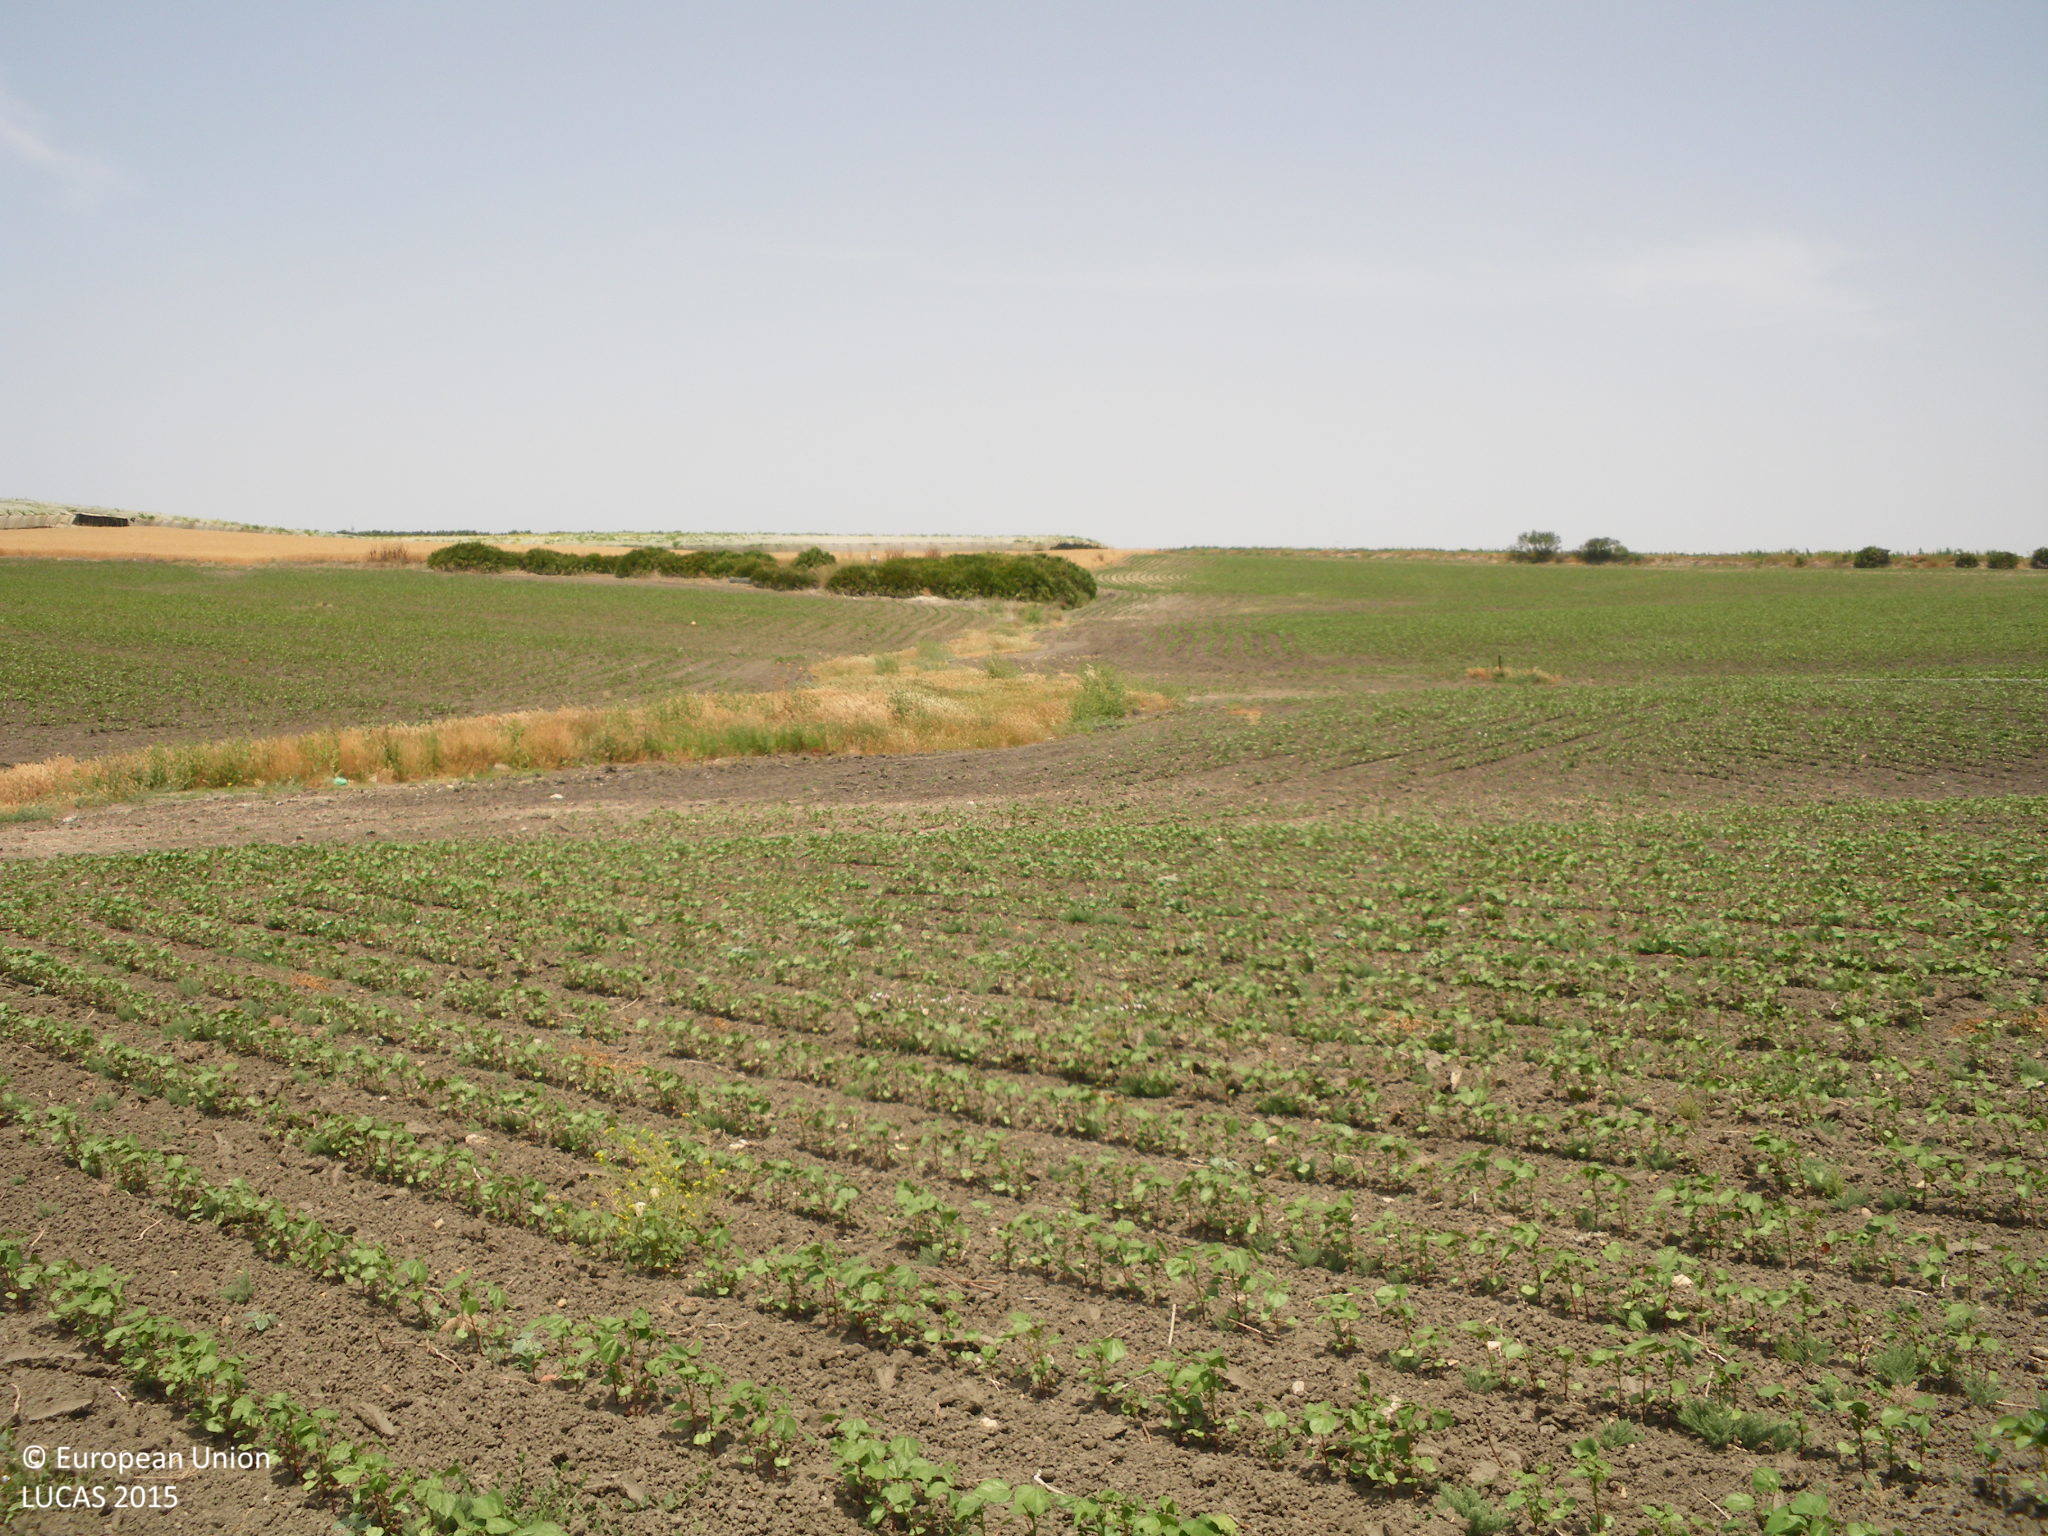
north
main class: Cropland
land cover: Cotton
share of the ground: 10 - 25 %
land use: Agriculture (excluding fallow land and kitchen gardens)
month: June
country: ES
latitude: 36.7060
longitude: -6.3710
